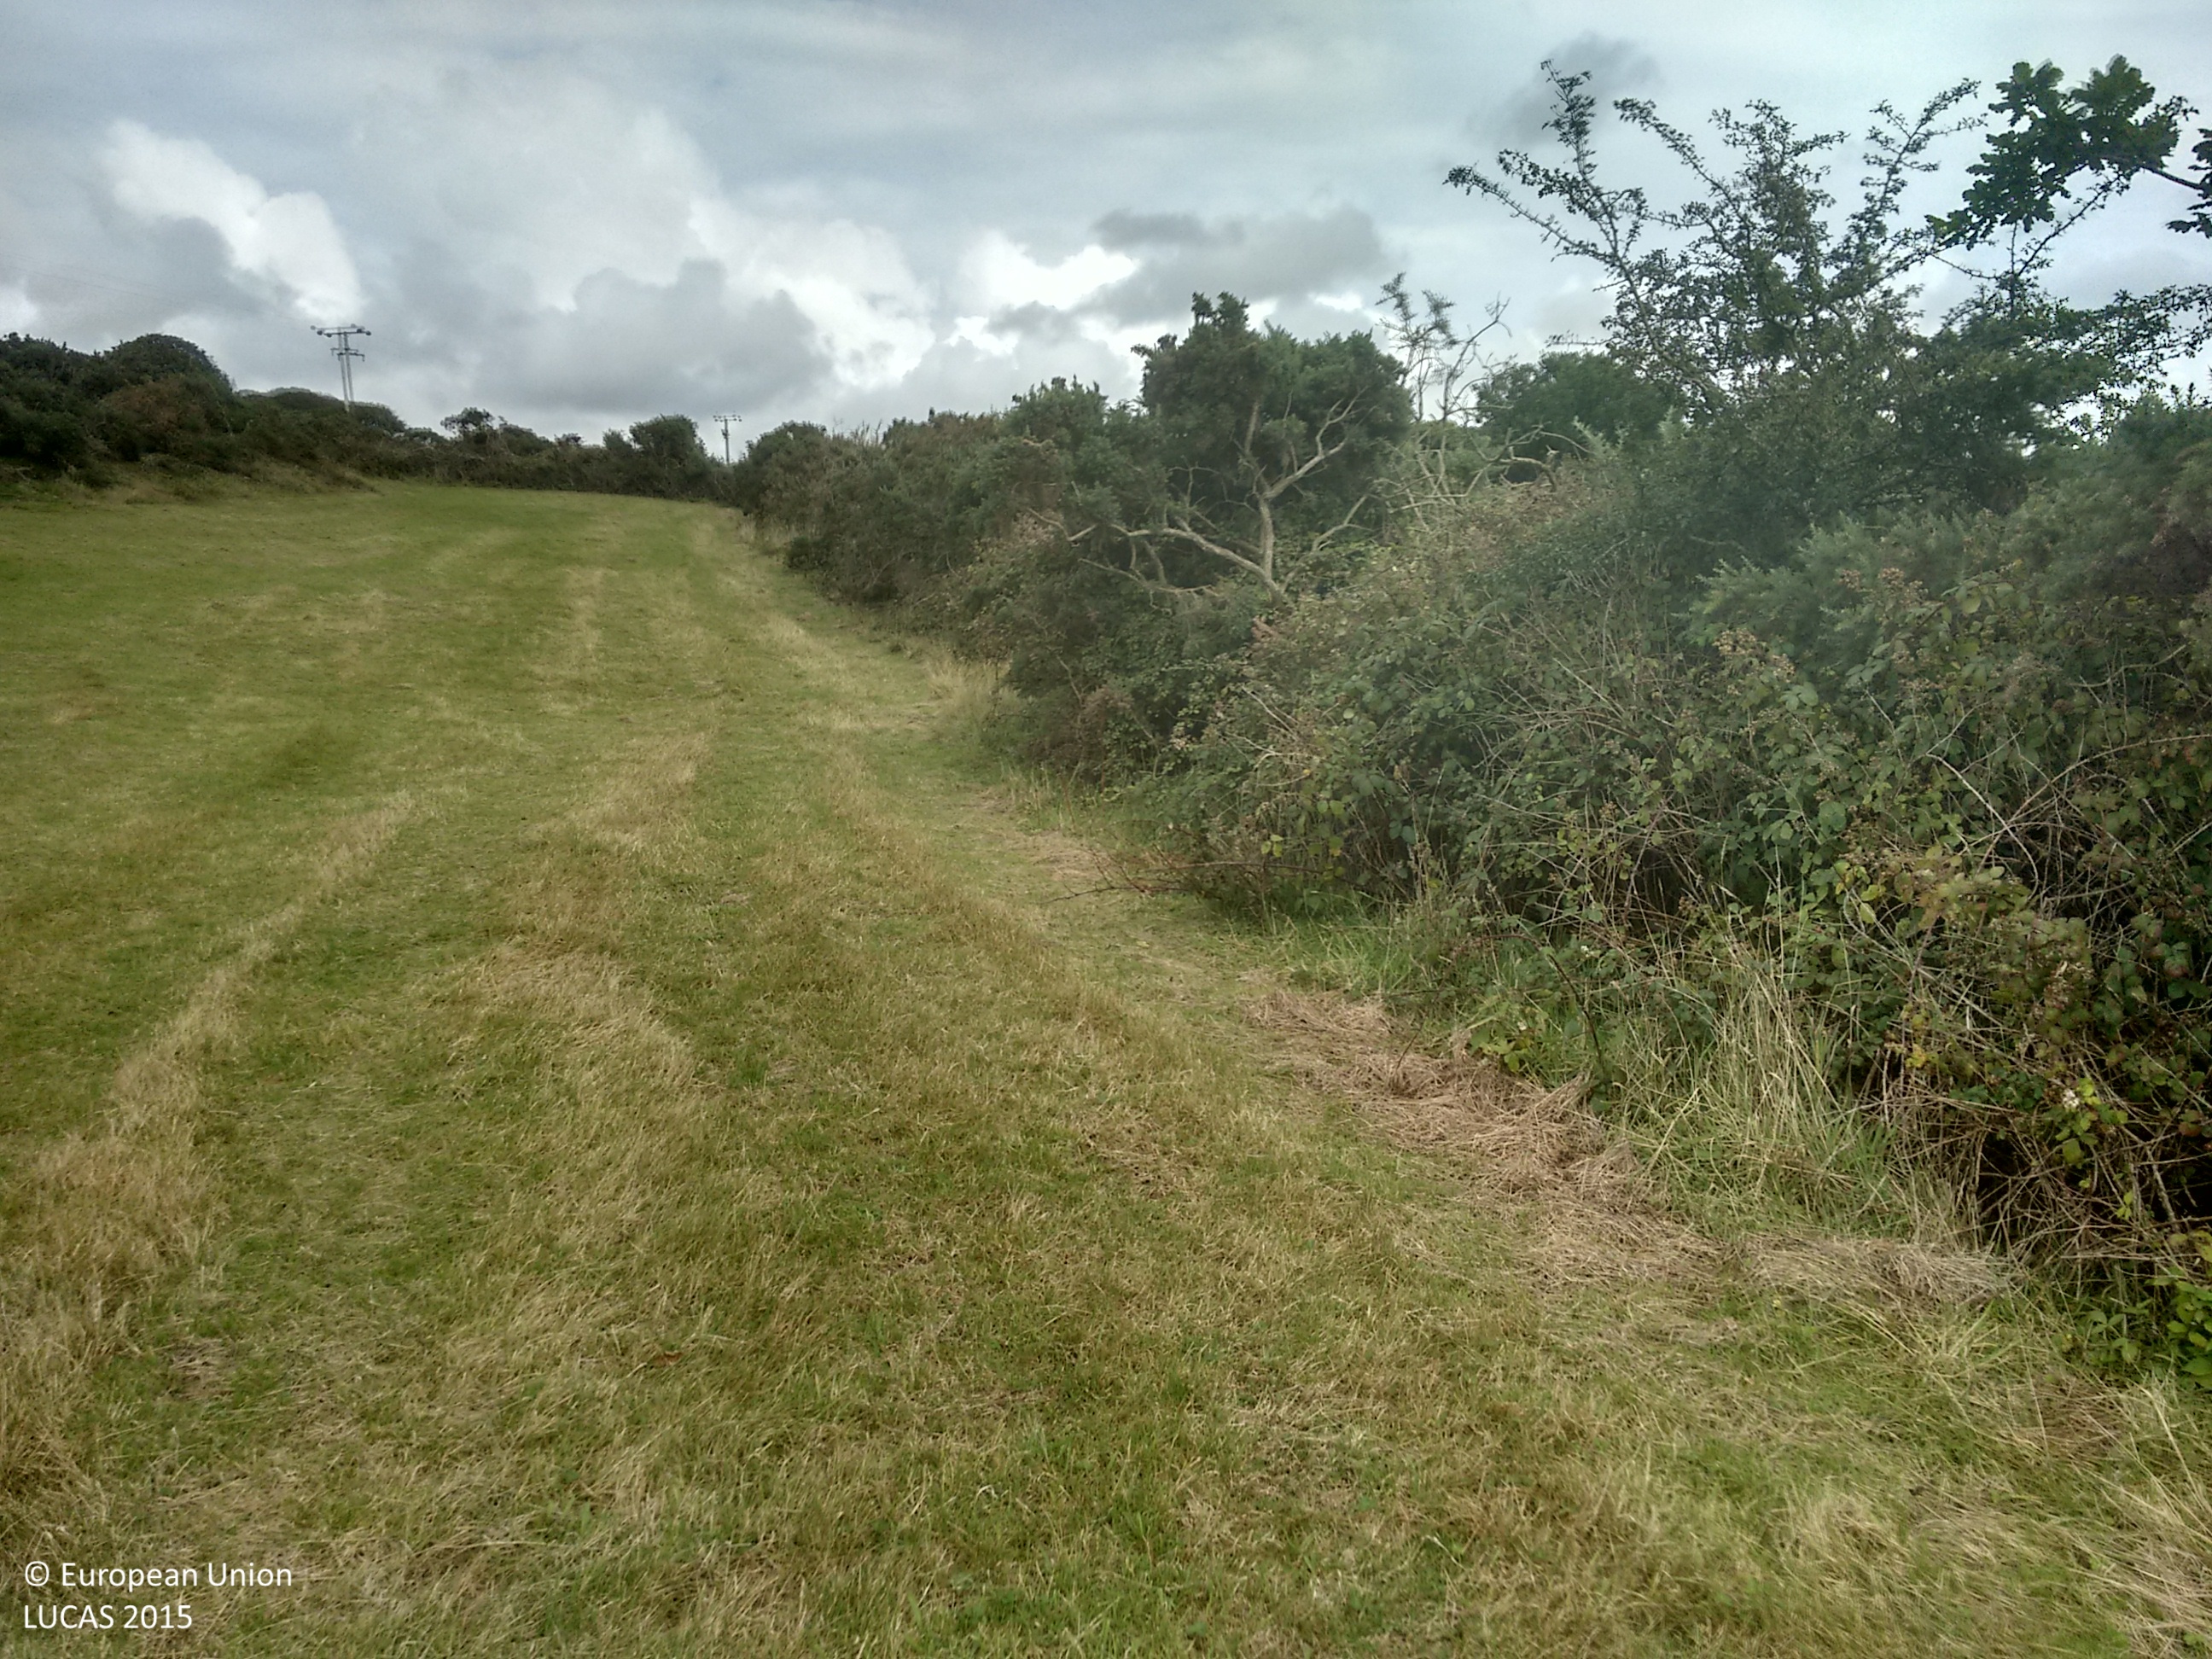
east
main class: Grassland
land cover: Grassland without tree/shrub cover
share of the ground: > 75 %
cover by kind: herbaceous plants 100 %
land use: Agriculture (excluding fallow land and kitchen gardens)
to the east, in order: Grassland without tree/shrub cover; Managed hedges; Dry stone walls; Paved roads, cycling and walking lanes; Grass margins; Paved roads, cycling and walking lanes; Grass margins; Managed hedges; Grassland without tree/shrub cover; Abandoned hedges; Electric lines; Abandoned hedges; Paved roads, cycling and walking lanes; Electric lines; Paved roads, cycling and walking lanes; Grass margins; Managed hedges
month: August
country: GB
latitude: 50.2243
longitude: -5.1591
